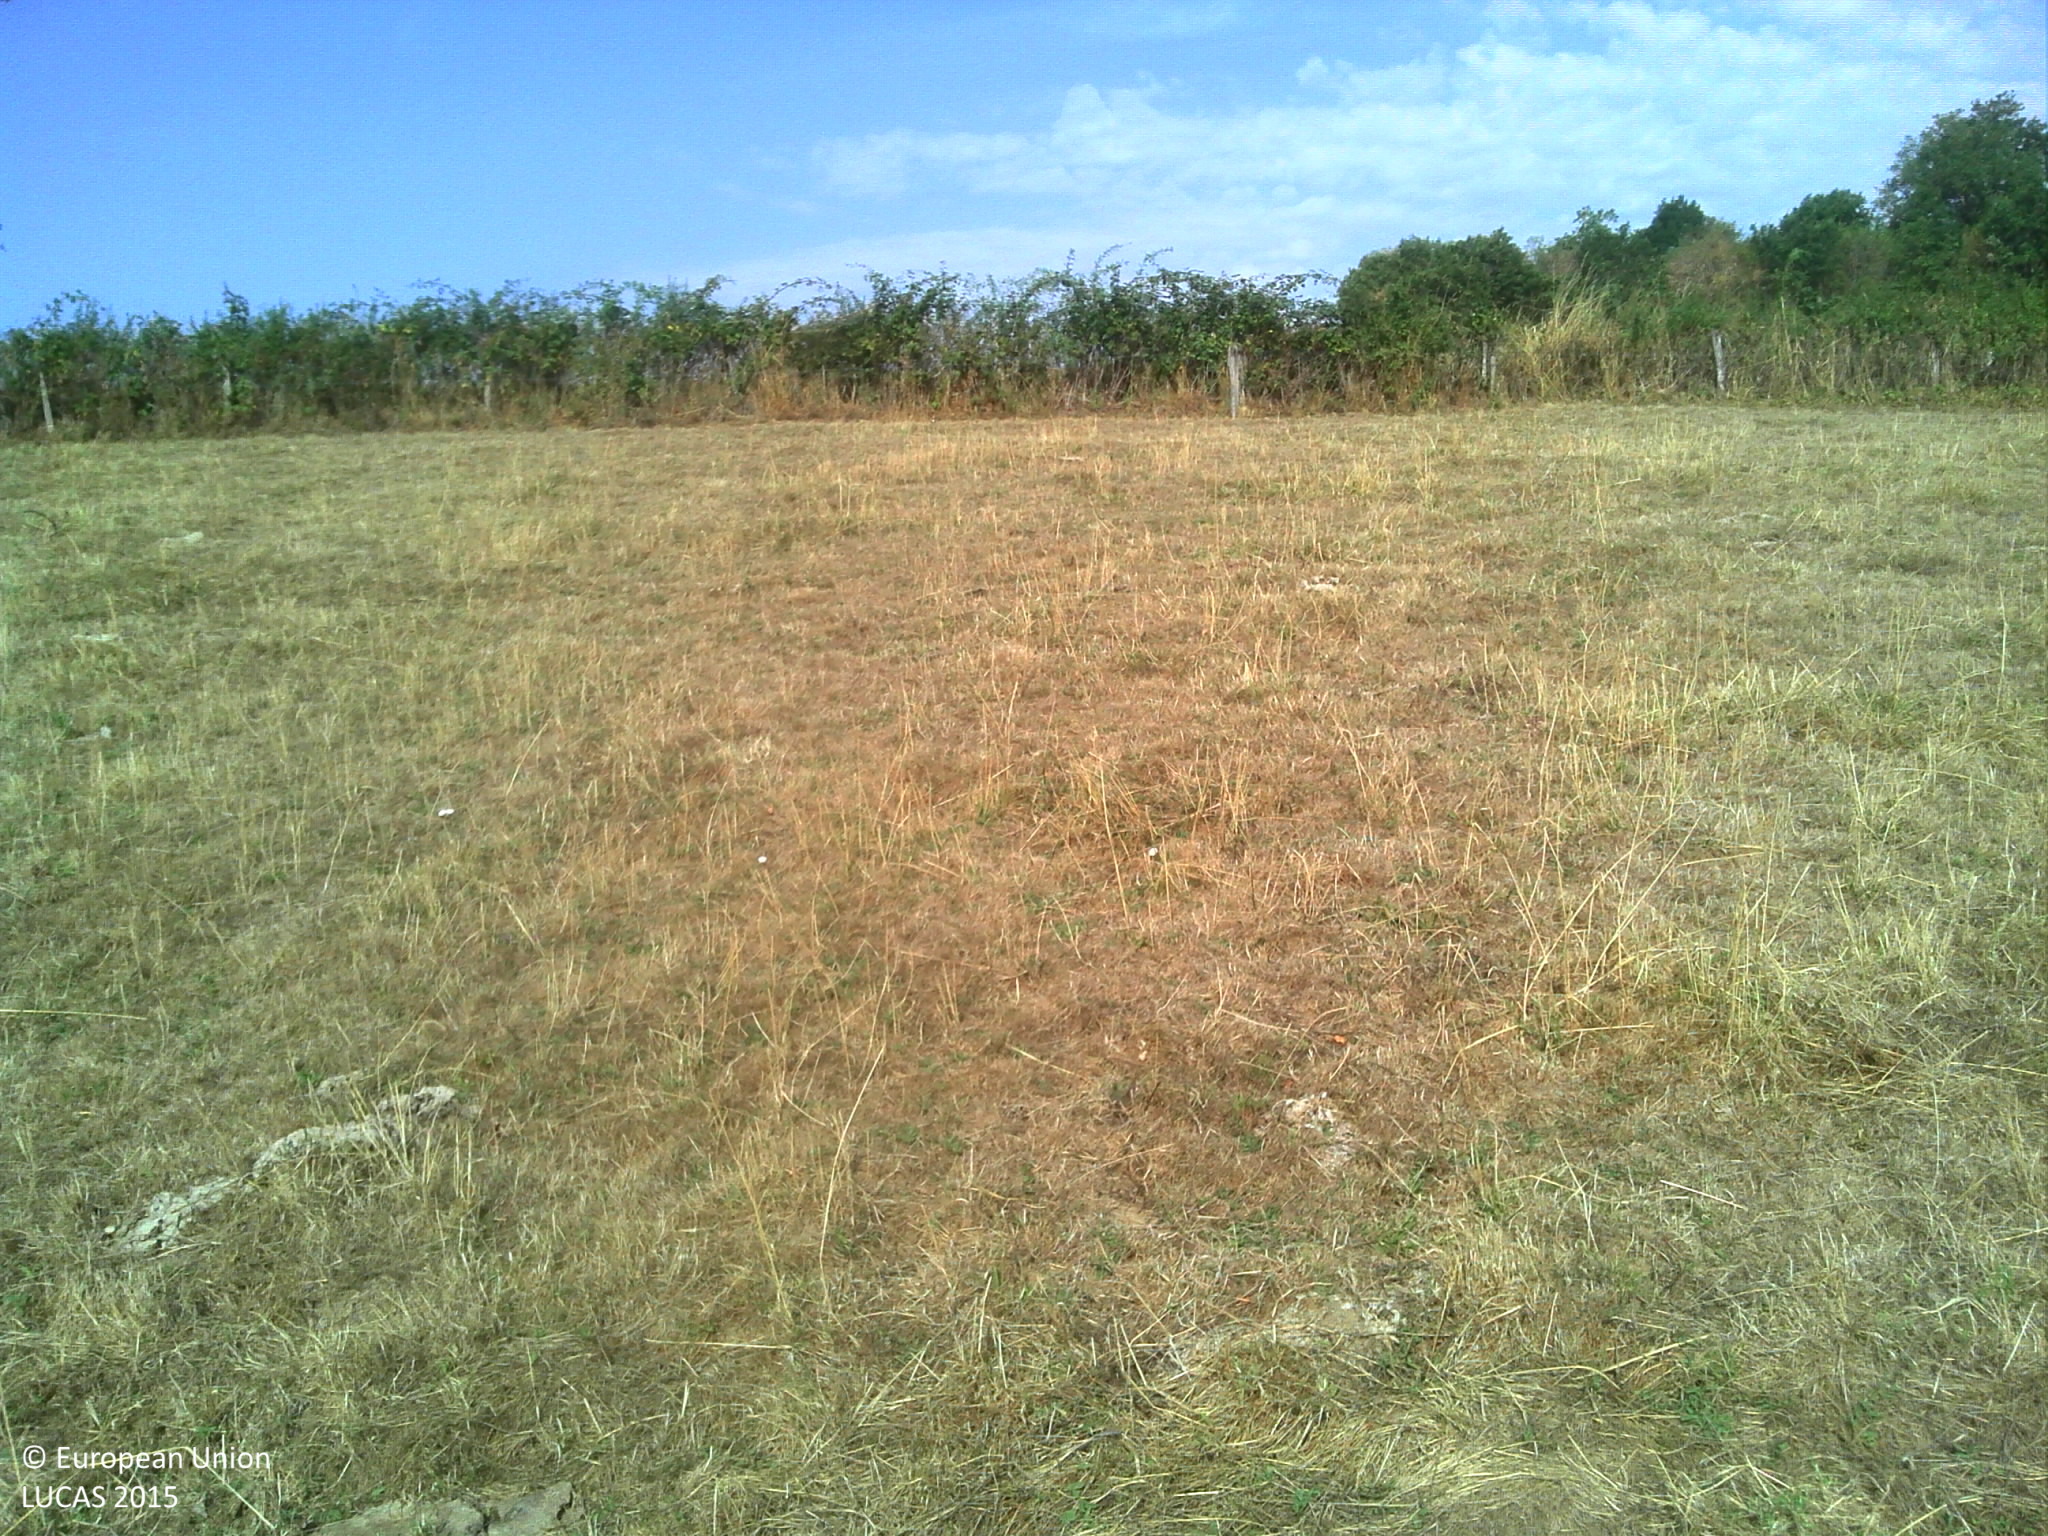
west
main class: Grassland
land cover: Grassland without tree/shrub cover
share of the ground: > 75 %
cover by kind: herbaceous plants 100 %
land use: Agriculture (excluding fallow land and kitchen gardens)
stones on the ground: 10 - 25 %
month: August
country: FR
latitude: 46.6928
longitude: 4.4170
